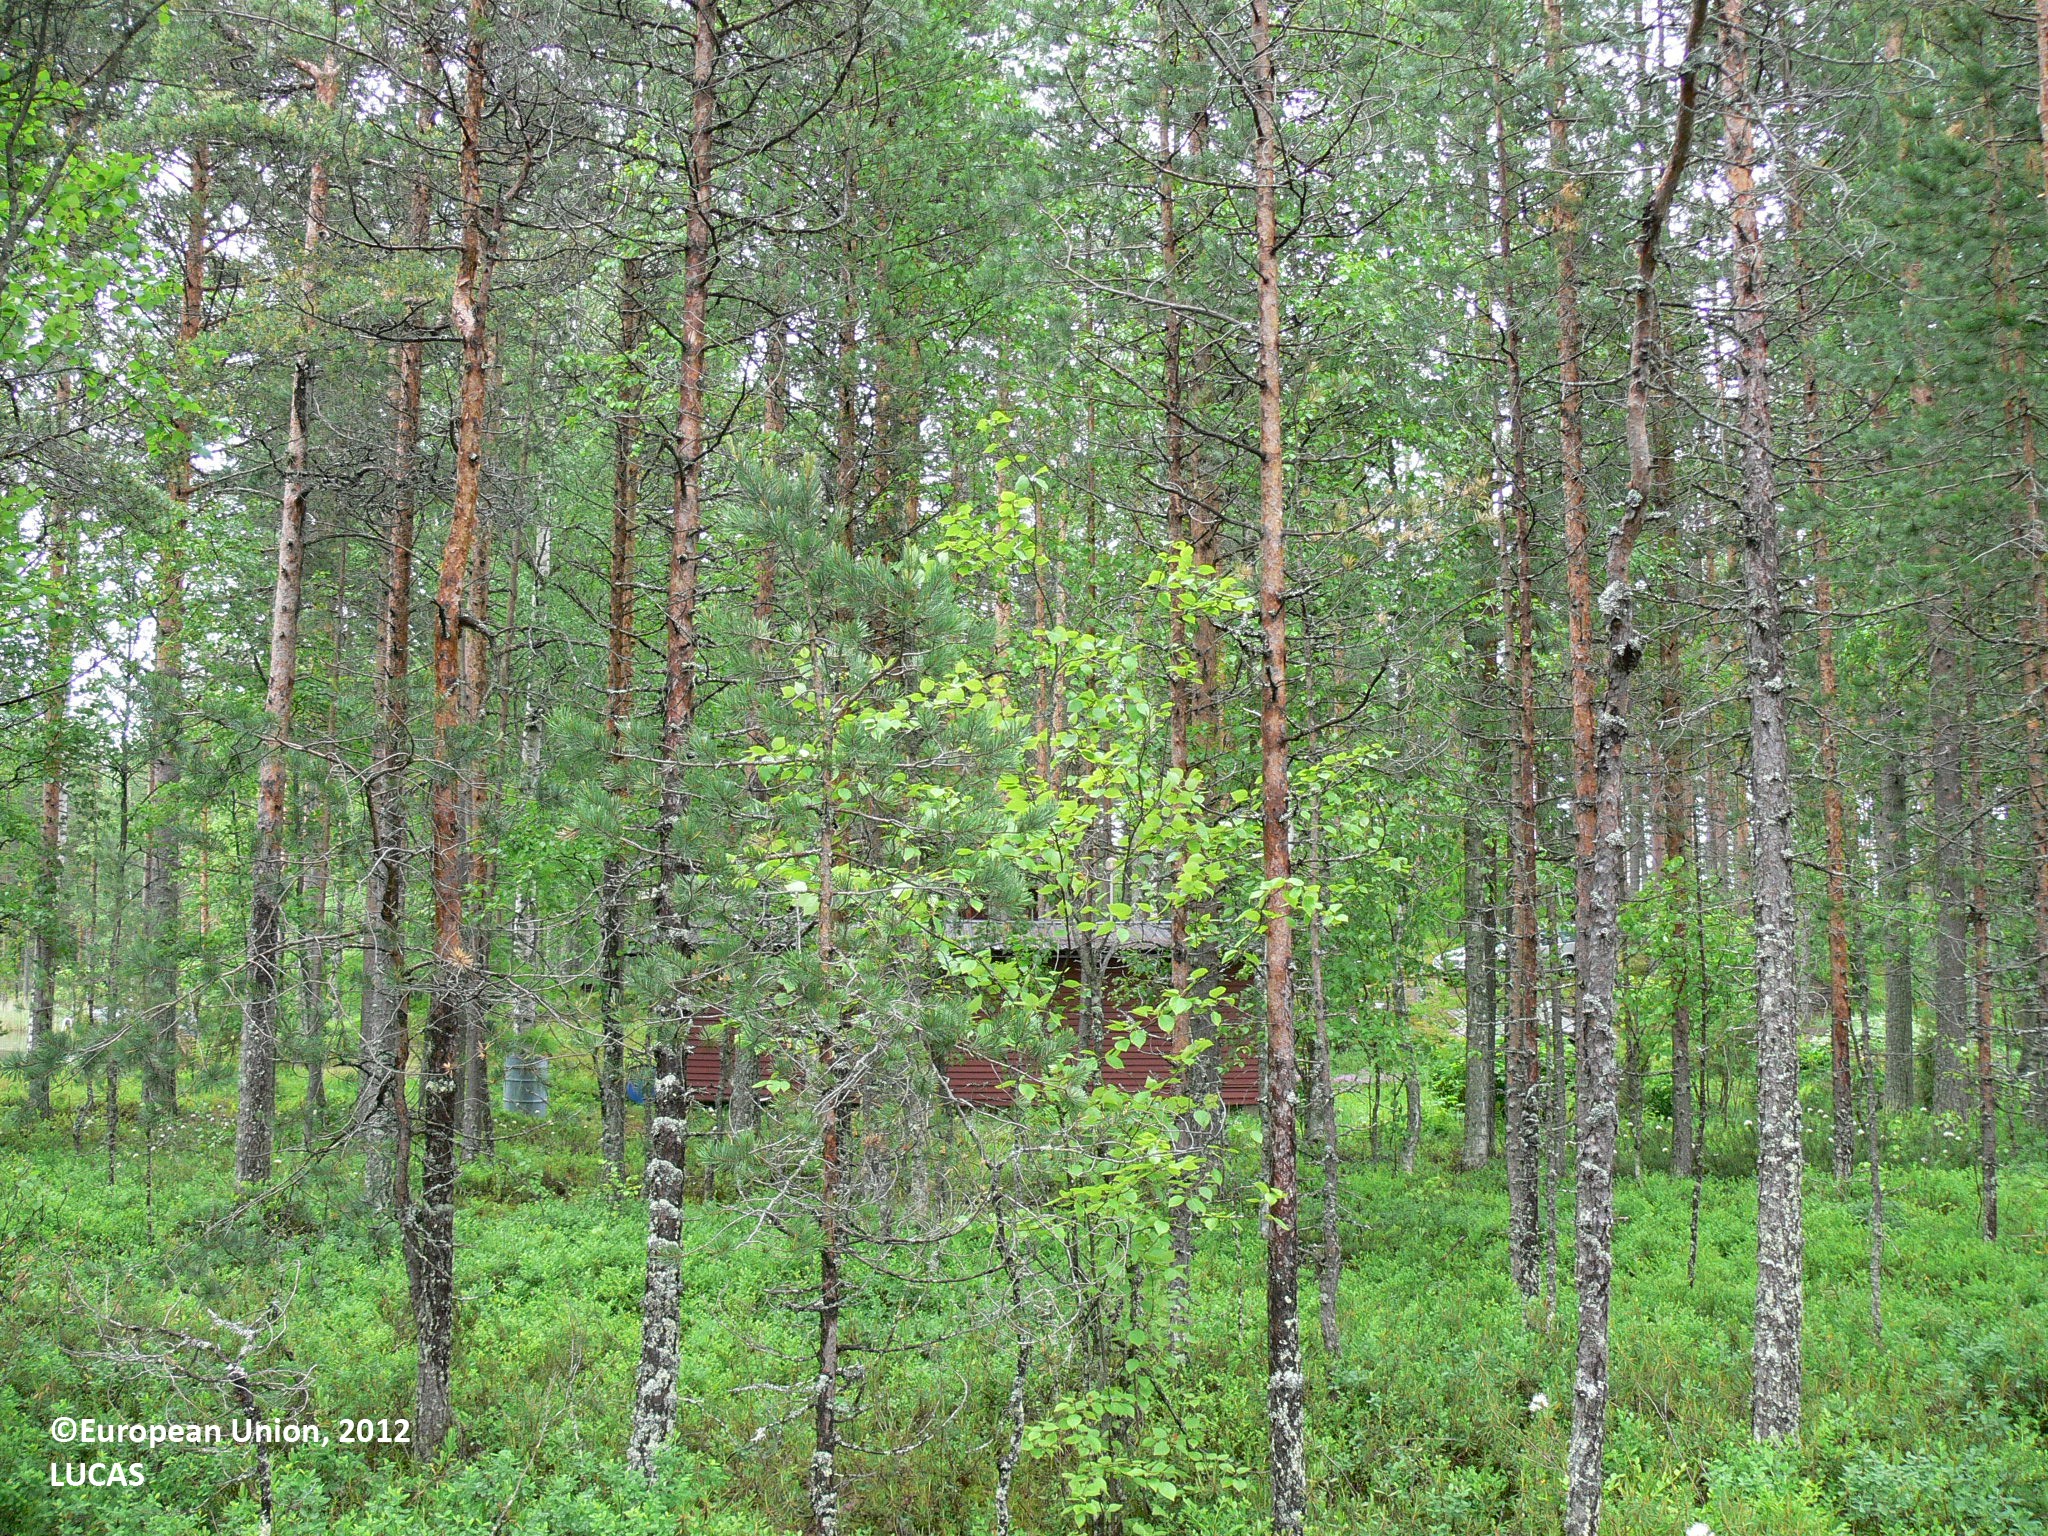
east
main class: Woodland
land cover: Pine dominated coniferous woodland
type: boreal forest
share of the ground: > 75 %
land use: Forestry
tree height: > 5 m
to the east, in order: Pine dominated coniferous woodland; Artificial constructions in urban areas; Pine dominated coniferous woodland; Tracks; Pine dominated coniferous woodland; Pine dominated mixed woodland; Ditches and canals; Pine dominated coniferous woodland; Other bare soil; Electric lines; Other bare soil; Pine dominated coniferous woodland
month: June
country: FI
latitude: 62.6468
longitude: 29.6144
